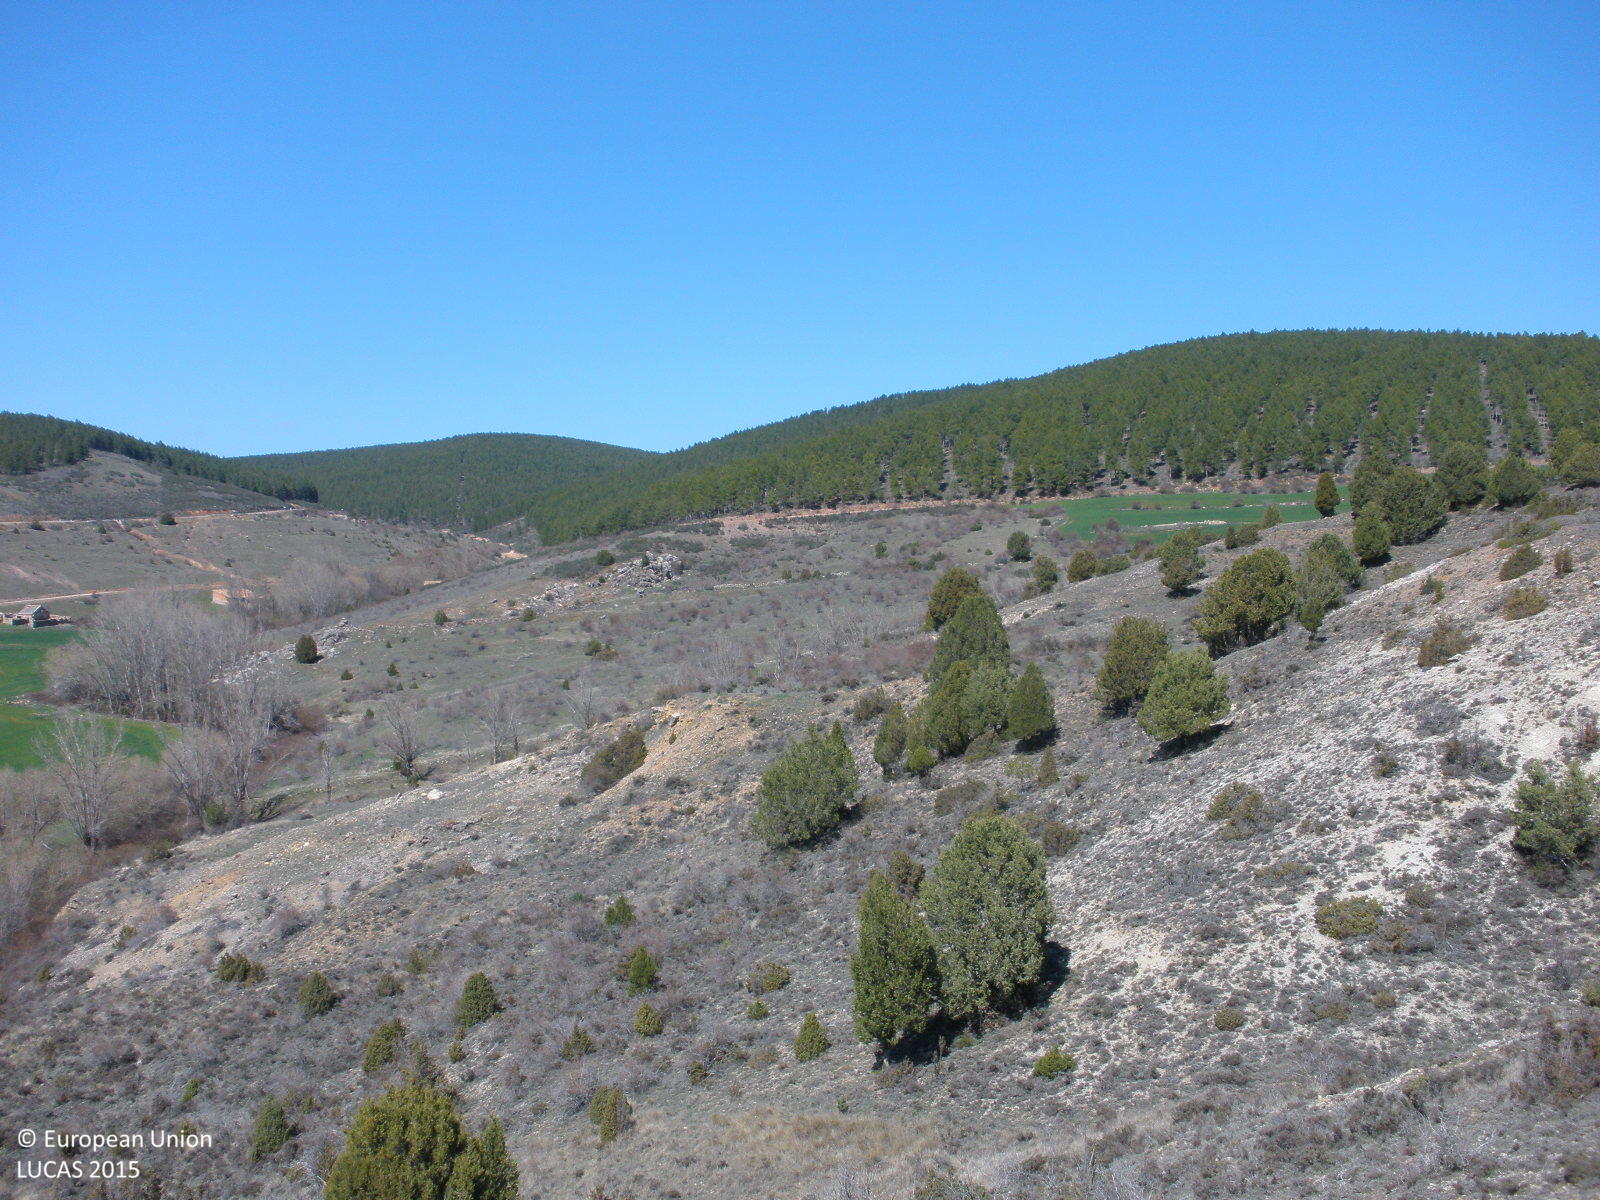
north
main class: Shrubland
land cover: Shrubland without tree cover
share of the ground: 50 - 75 %
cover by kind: shrubs 70 %, consolidated bare surface 30 %
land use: Semi-natural and natural areas not in use
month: April
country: ES
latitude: 40.9818
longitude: -1.1300
